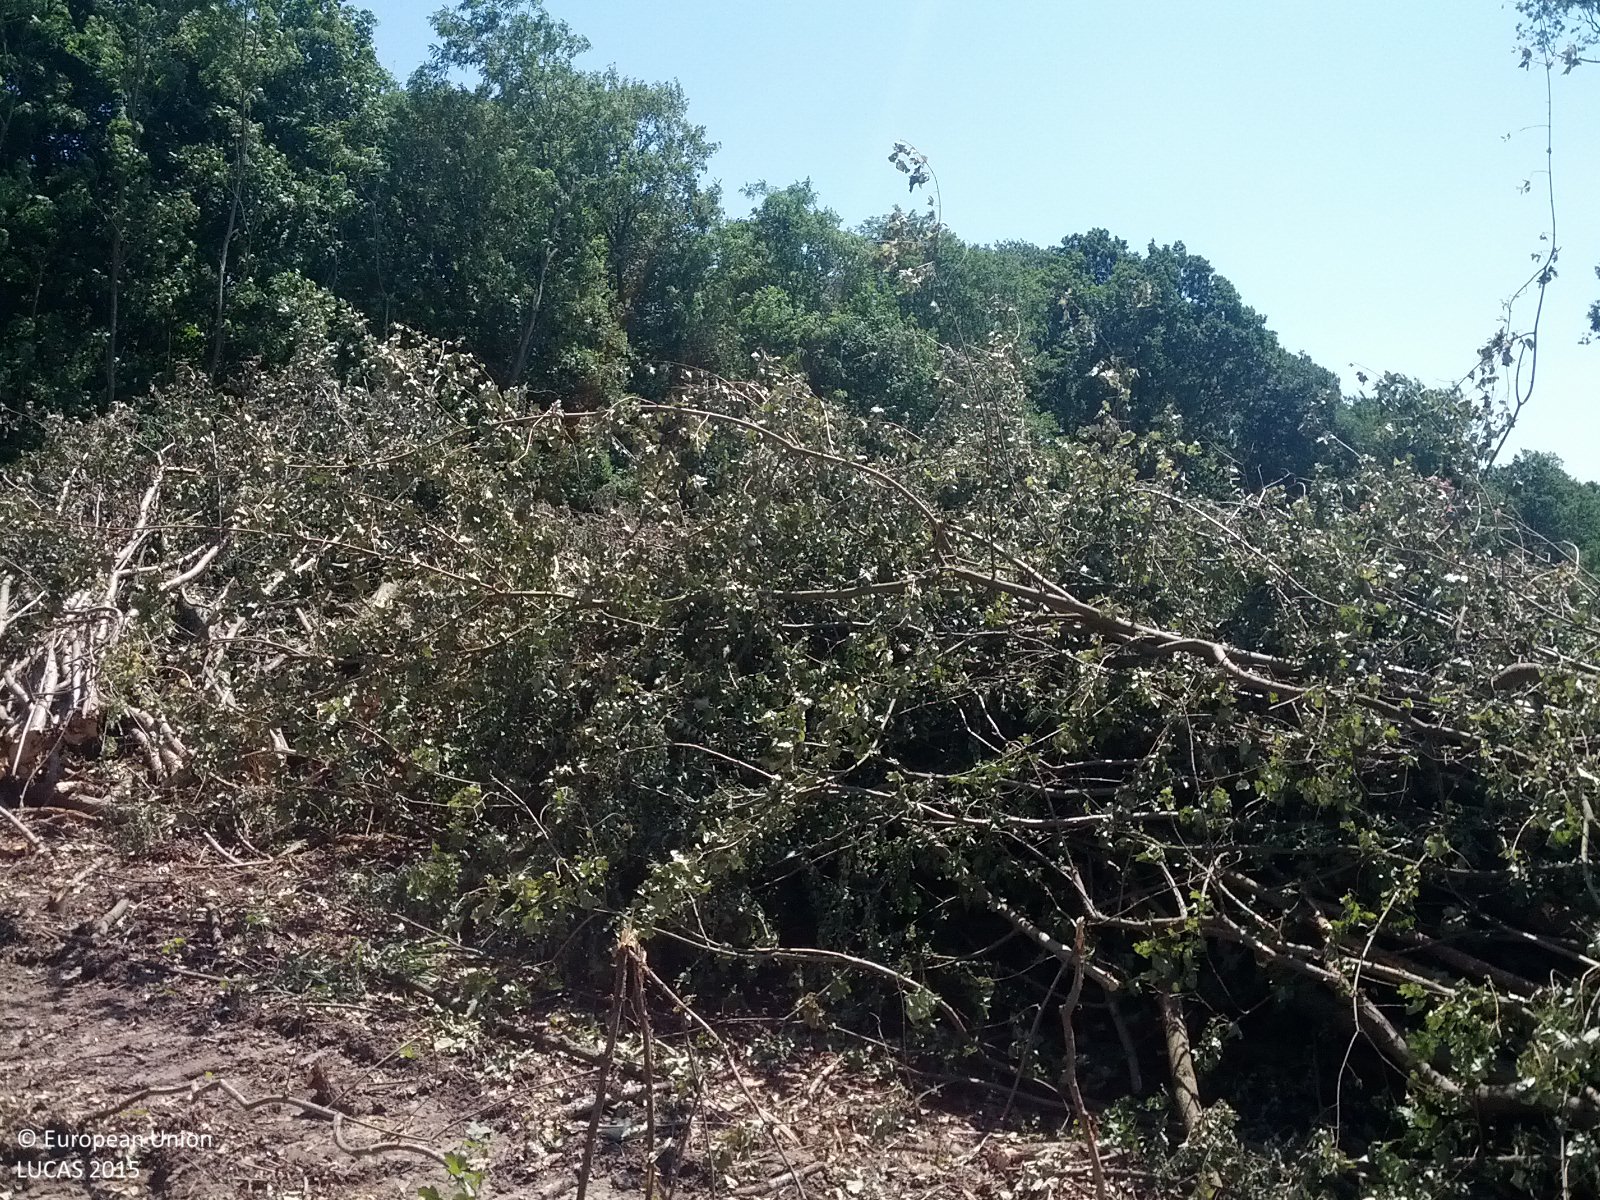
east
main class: Woodland
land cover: Broadleaved woodland
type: mesophytic deciduous forest
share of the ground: < 10 %
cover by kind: unconsolidated bare surface 90 %, broadleaved forest trees 10 %
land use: Forestry
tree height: > 5 m
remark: Clear cut
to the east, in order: Broadleaved woodland; Tracks; Broadleaved woodland
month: July
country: AT
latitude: 48.6239
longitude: 16.5592
